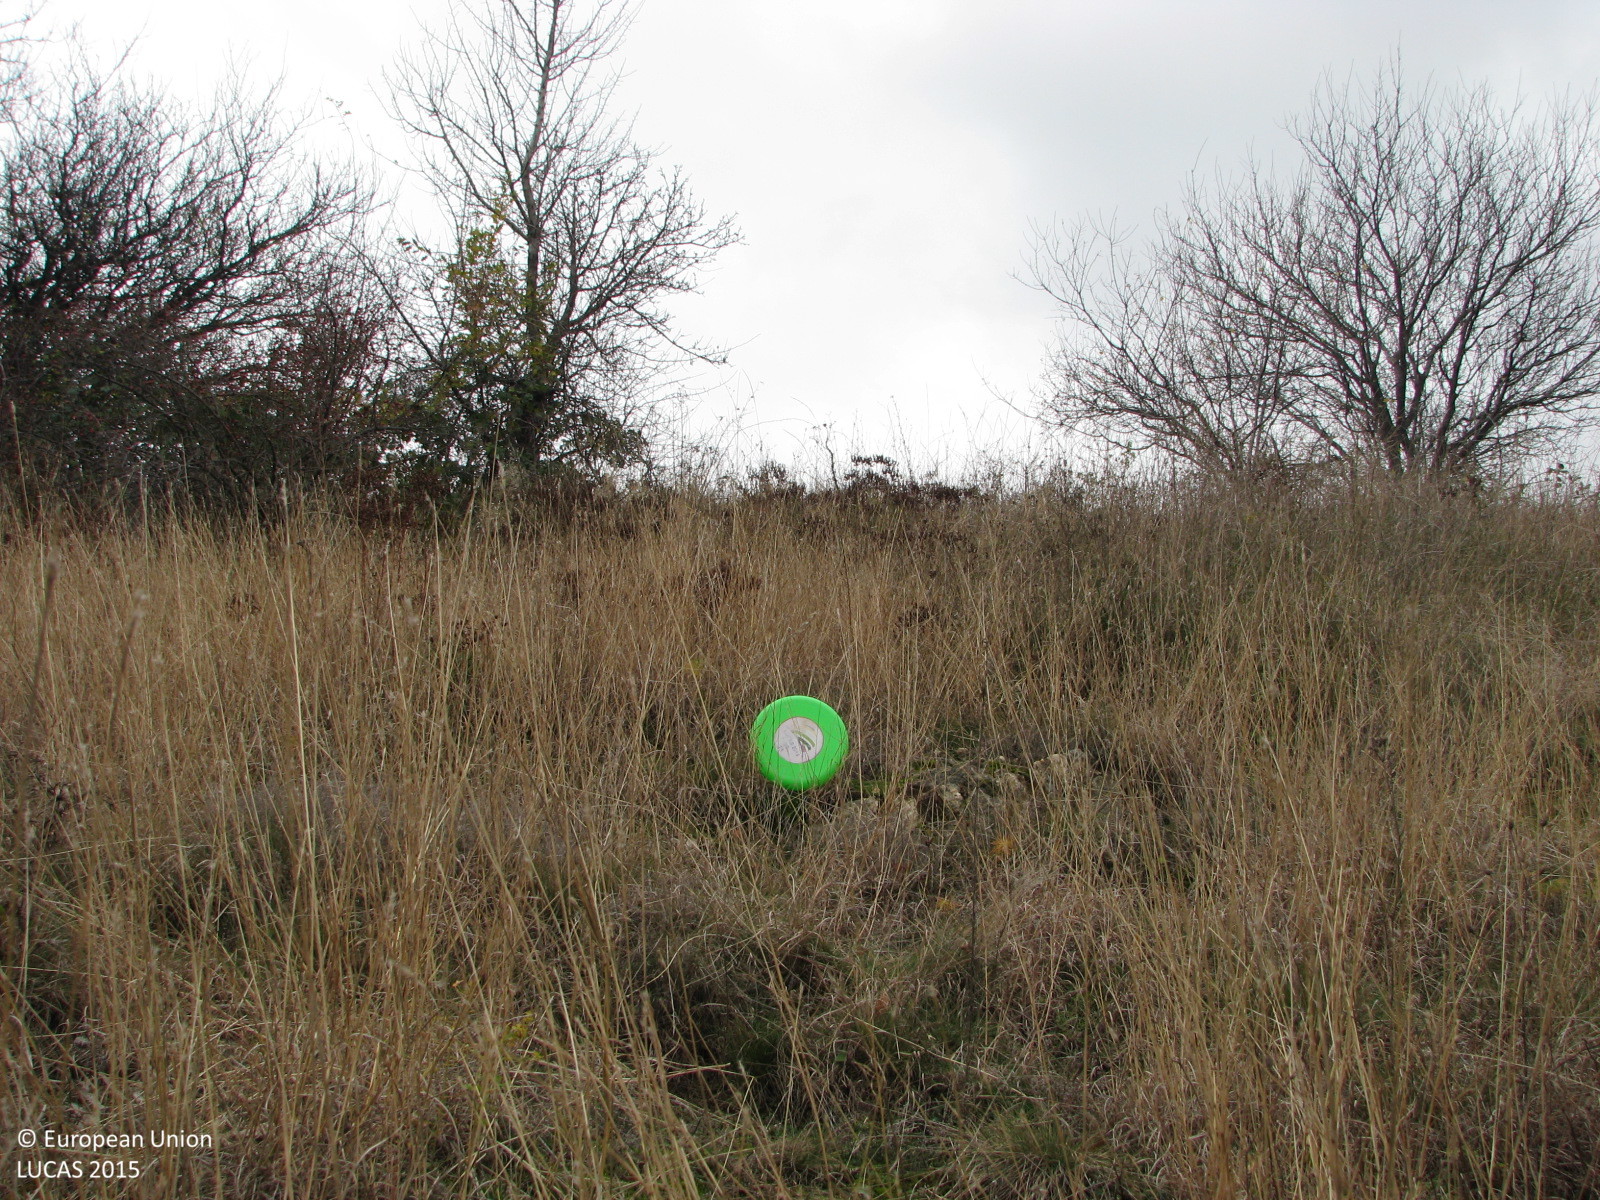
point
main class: Grassland
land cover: Grassland with sparse tree/shrub cover
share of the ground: > 75 %
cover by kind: herbaceous plants 80 %, broadleaved forest trees 5 %, shrubs 5 %, lichens and mosses 5 %, unconsolidated bare surface 5 %
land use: Semi-natural and natural areas not in use
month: December
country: BG
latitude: 42.3304
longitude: 24.0339
